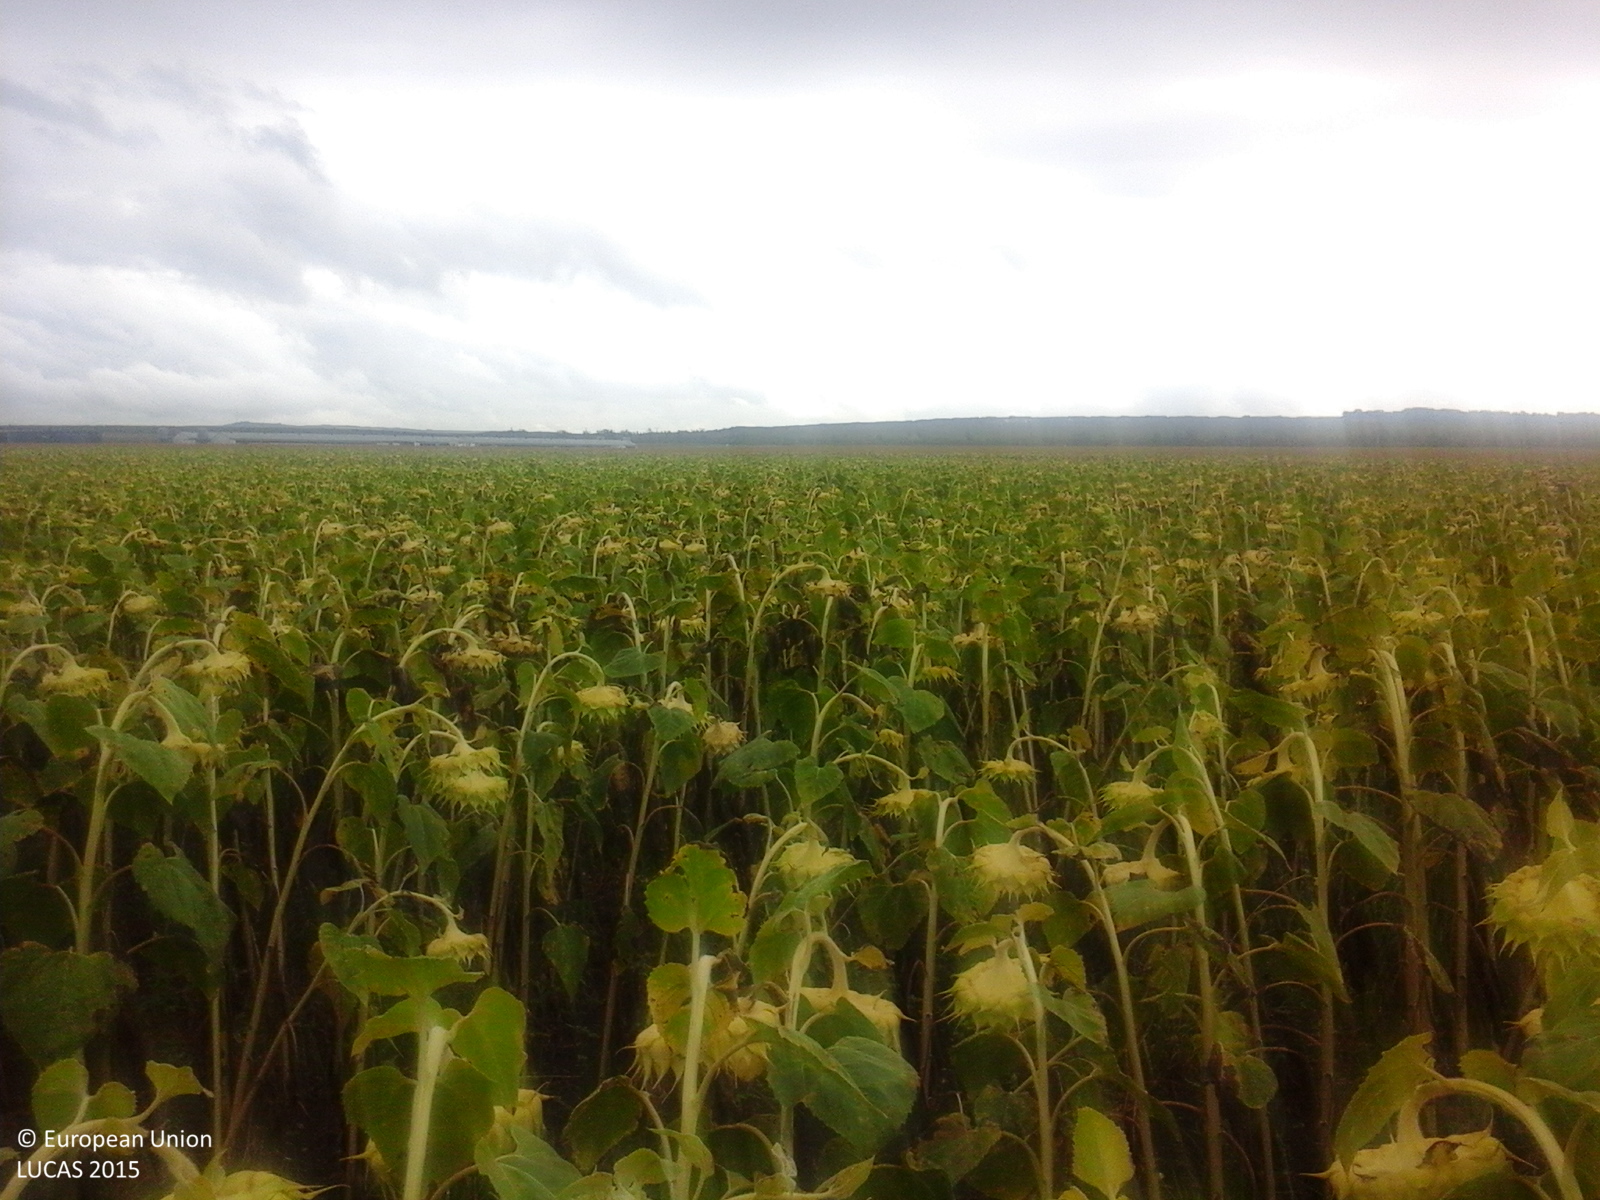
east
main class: Cropland
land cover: Sunflower
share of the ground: > 75 %
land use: Agriculture (excluding fallow land and kitchen gardens)
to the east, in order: Sunflower; Grass margins; Tracks; Grass margins; Other cereals
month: August
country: RO
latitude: 45.5773
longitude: 21.5542
